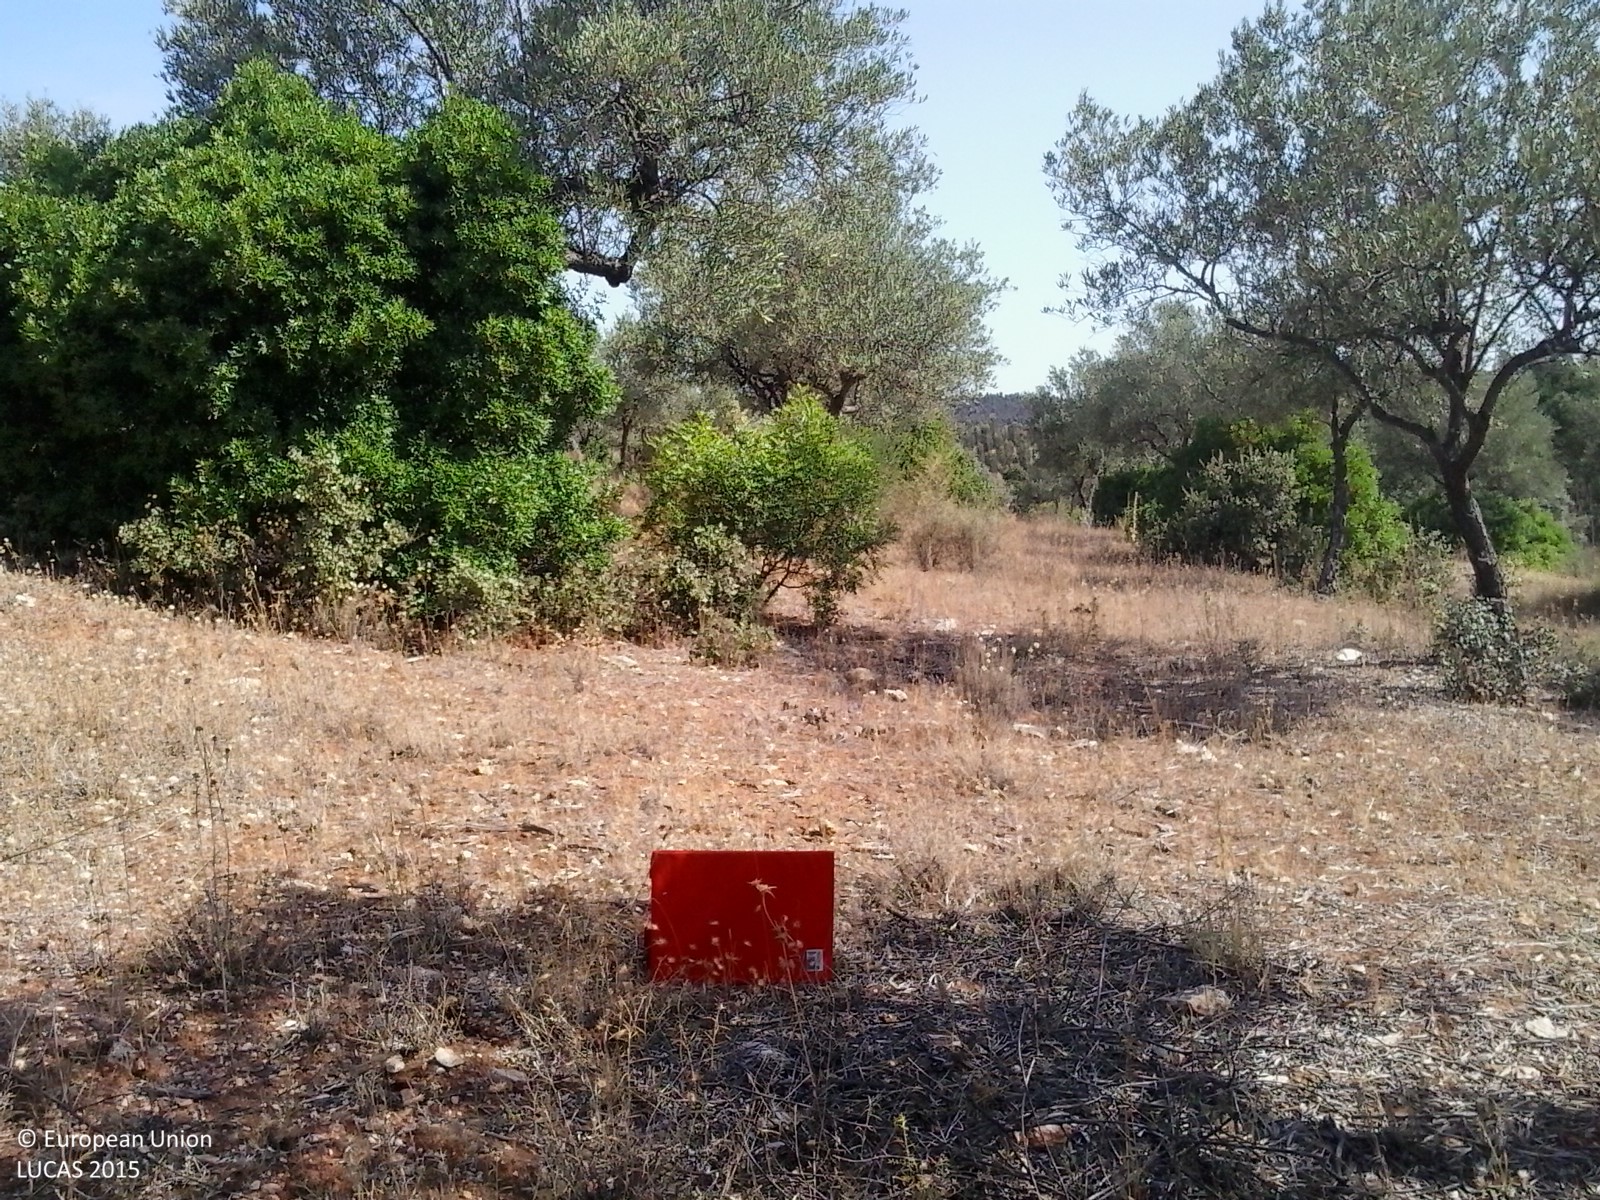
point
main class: Cropland
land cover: Olive groves
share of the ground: 25 - 50 %
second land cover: Spontaneously vegetated surfaces
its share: 50 - 75 %
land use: Agriculture (excluding fallow land and kitchen gardens)
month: July
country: ES
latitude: 37.4788
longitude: -6.4876
